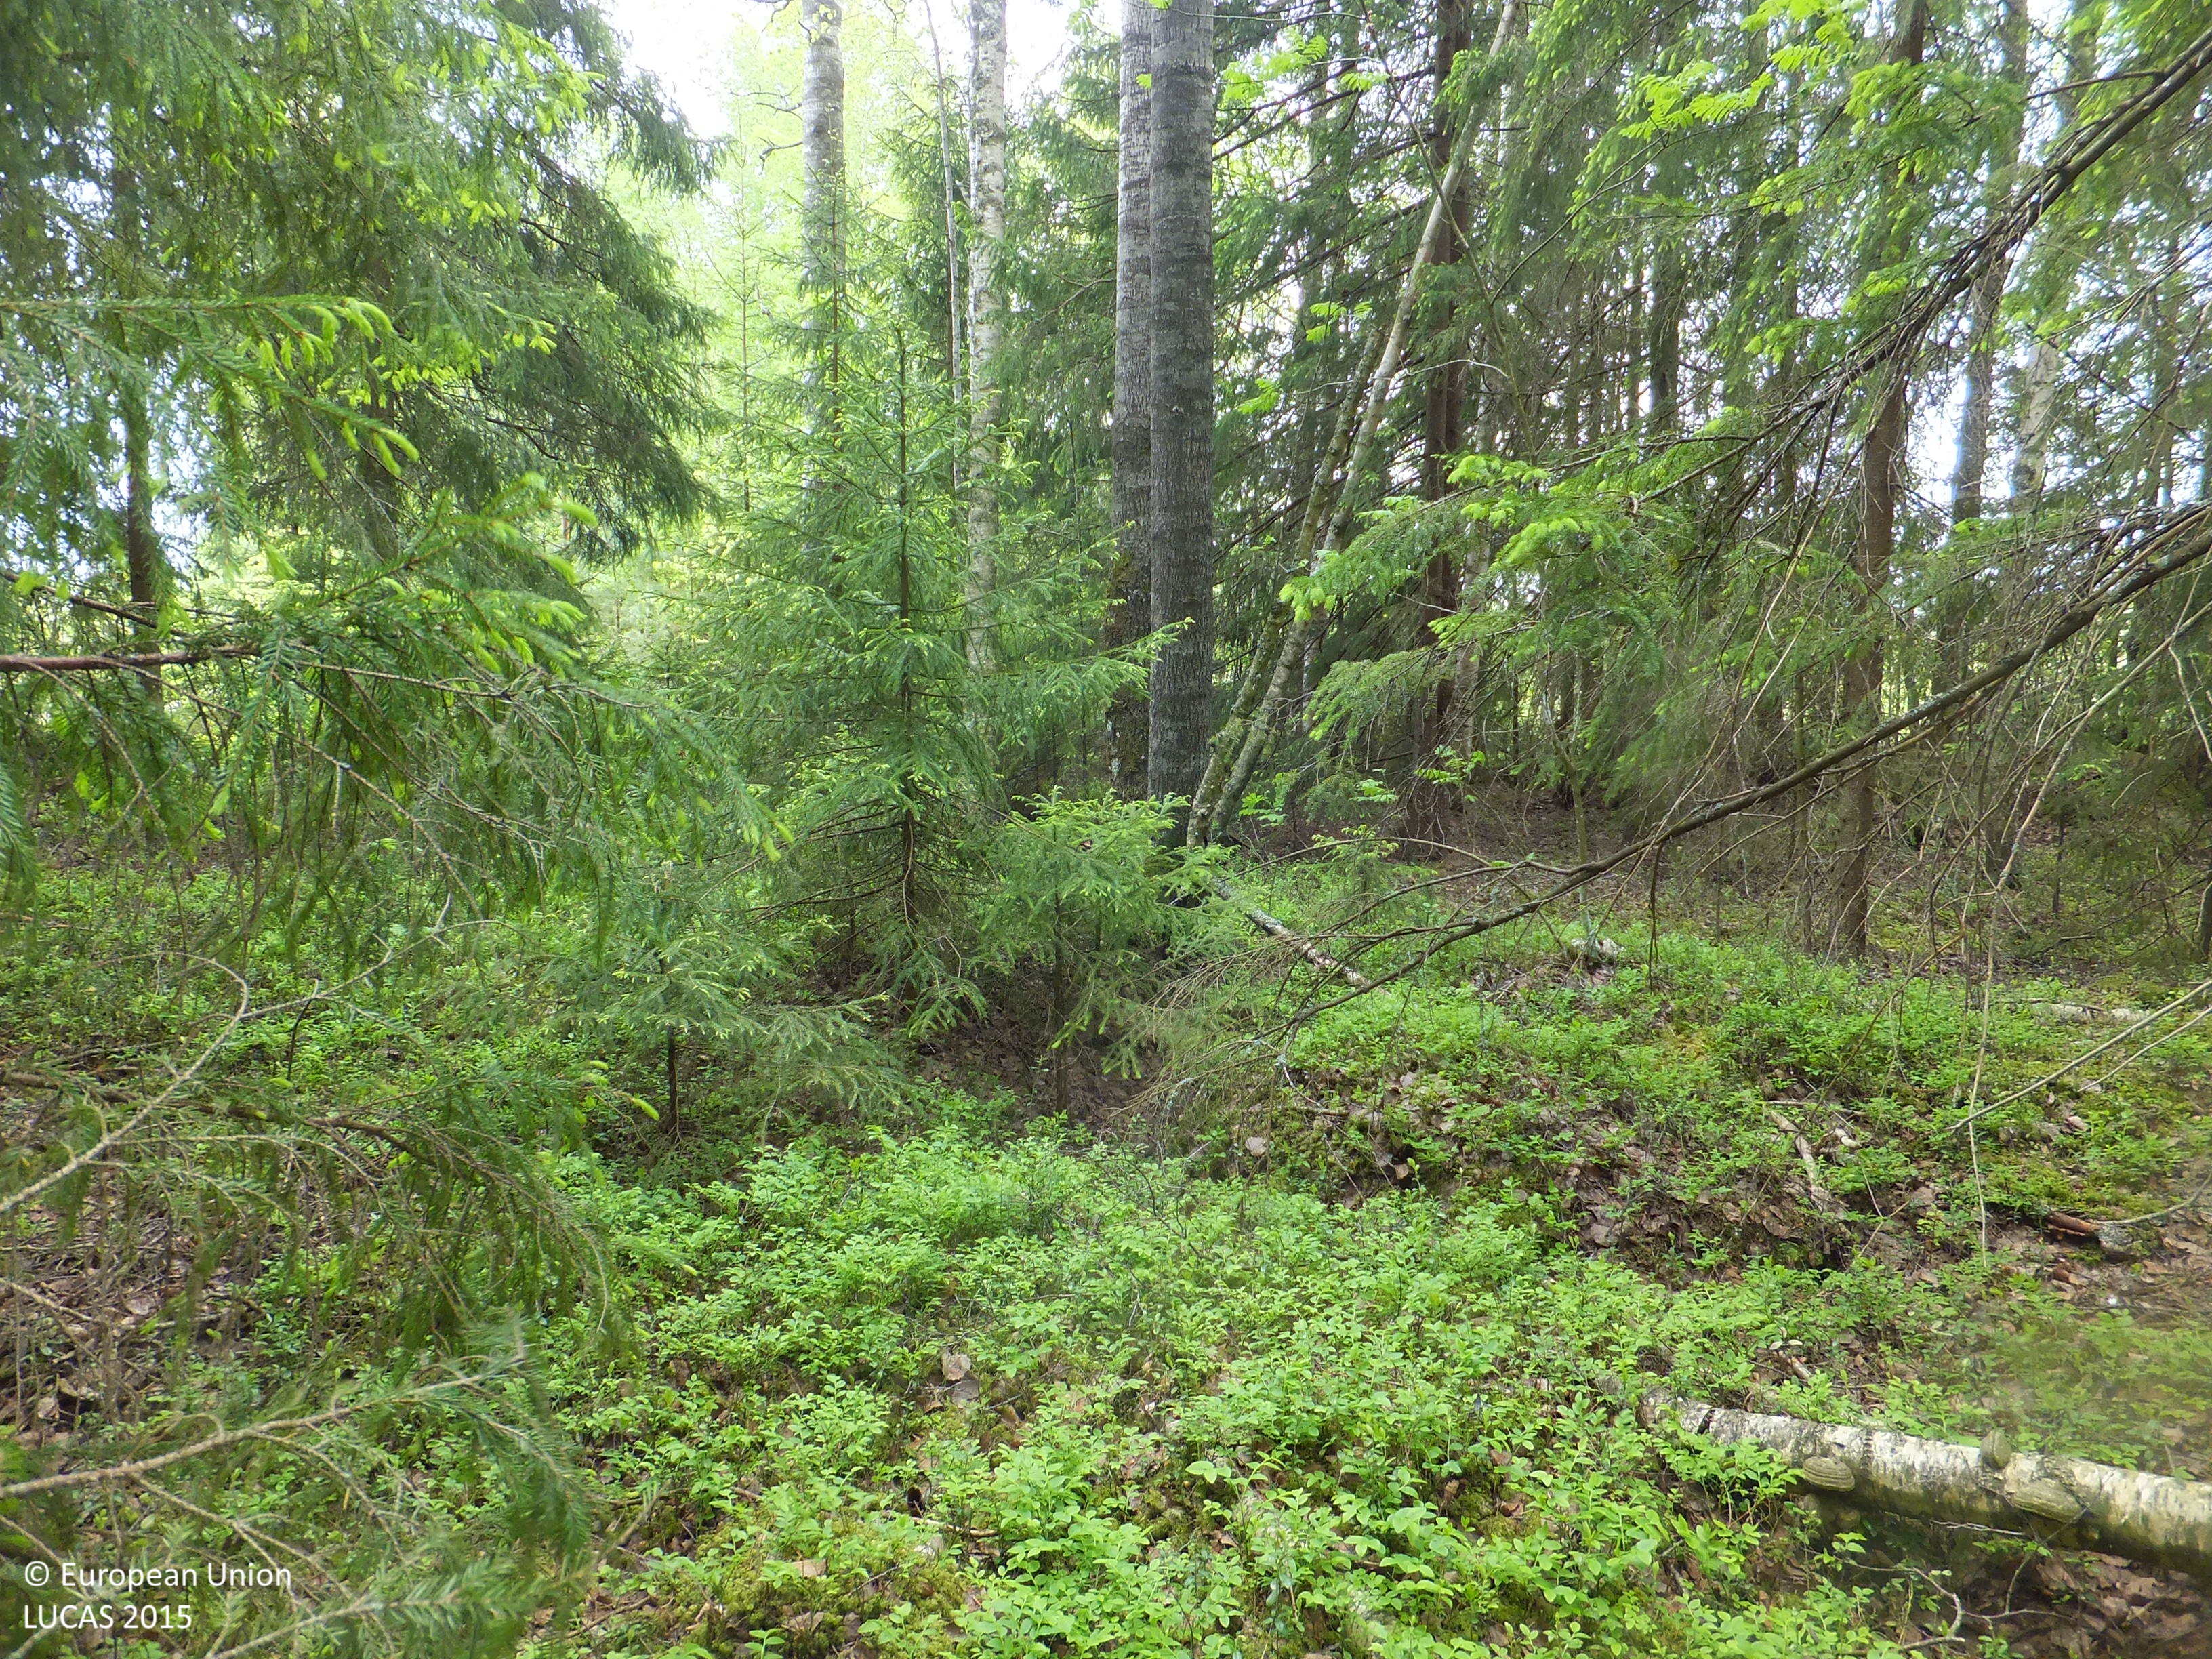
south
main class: Woodland
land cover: Spruce dominated mixed woodland
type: boreal forest
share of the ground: > 75 %
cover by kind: coniferous forest trees 55 %, broadleaved forest trees 20 %, shrubs 10 %, lichens and mosses 10 %, herbaceous plants 5 %
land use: Forestry
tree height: > 5 m
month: June
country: FI
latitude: 63.1866
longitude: 22.5089
